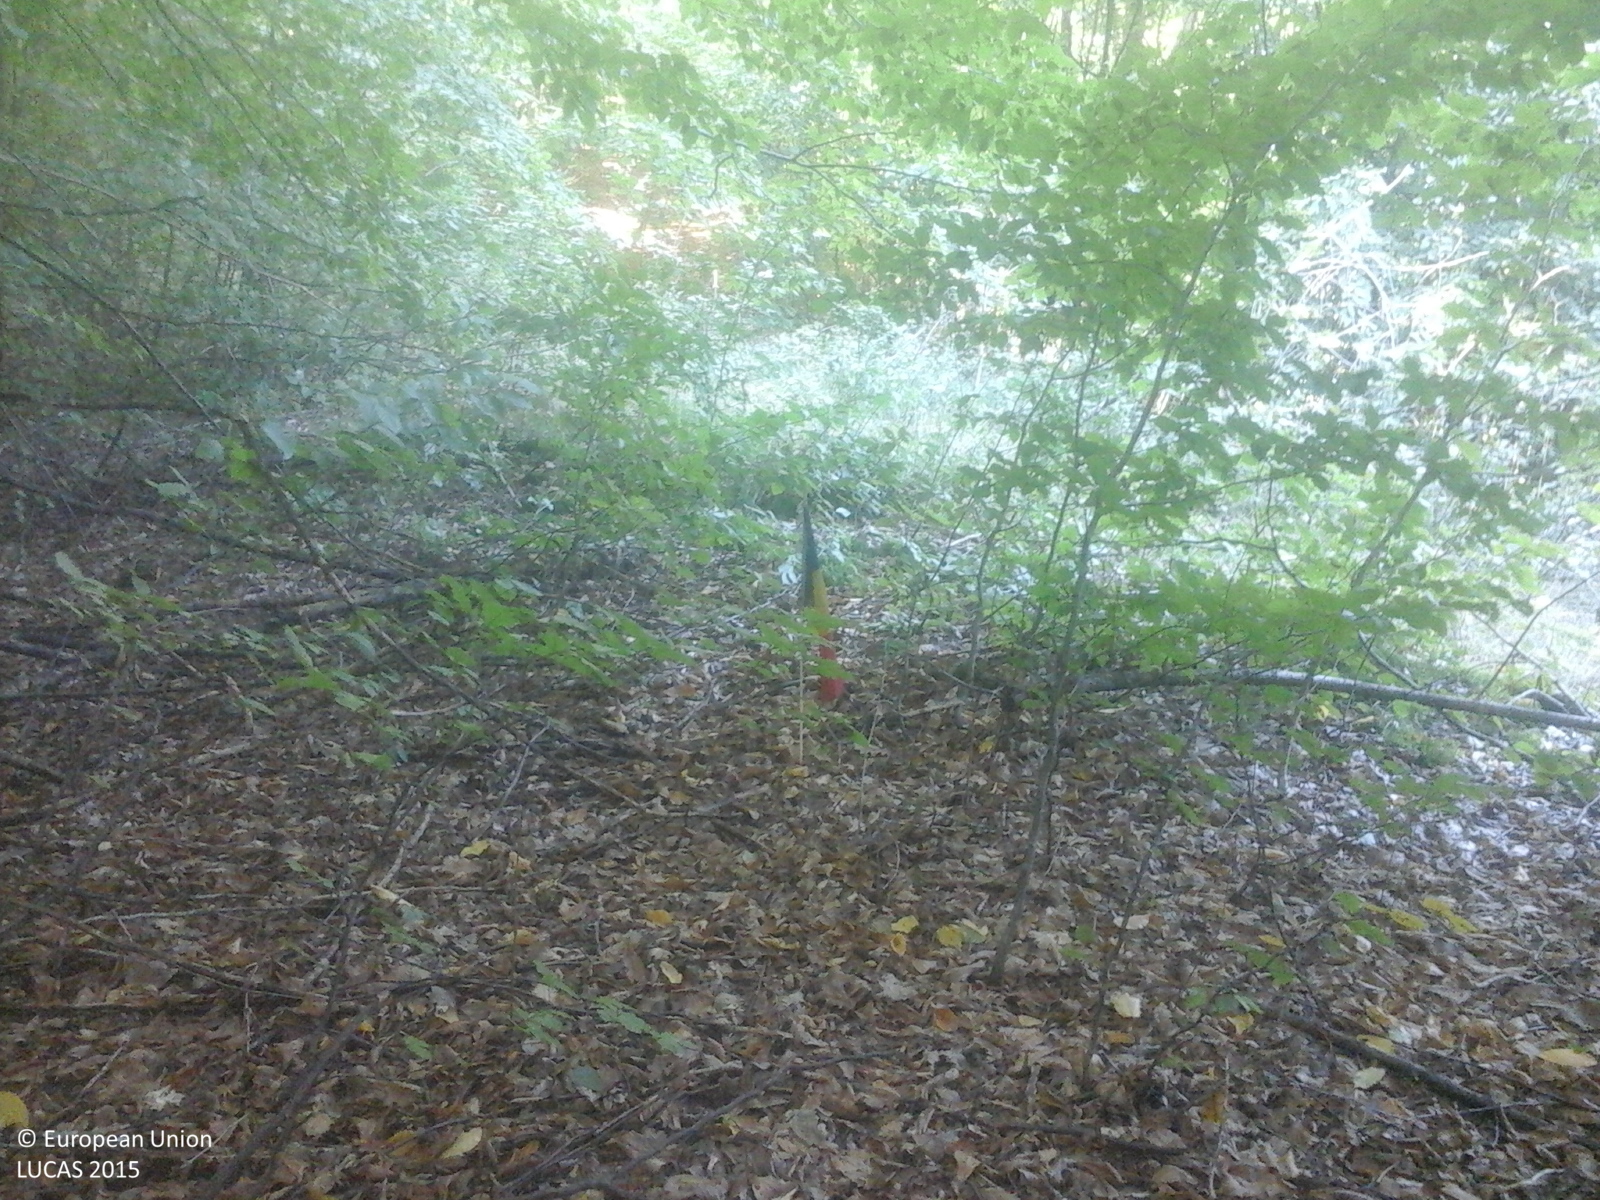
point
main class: Woodland
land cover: Broadleaved woodland
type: mesophytic deciduous forest
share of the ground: > 75 %
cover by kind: broadleaved forest trees 100 %
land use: Forestry
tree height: > 5 m
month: September
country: RO
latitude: 46.7854
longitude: 22.4571
